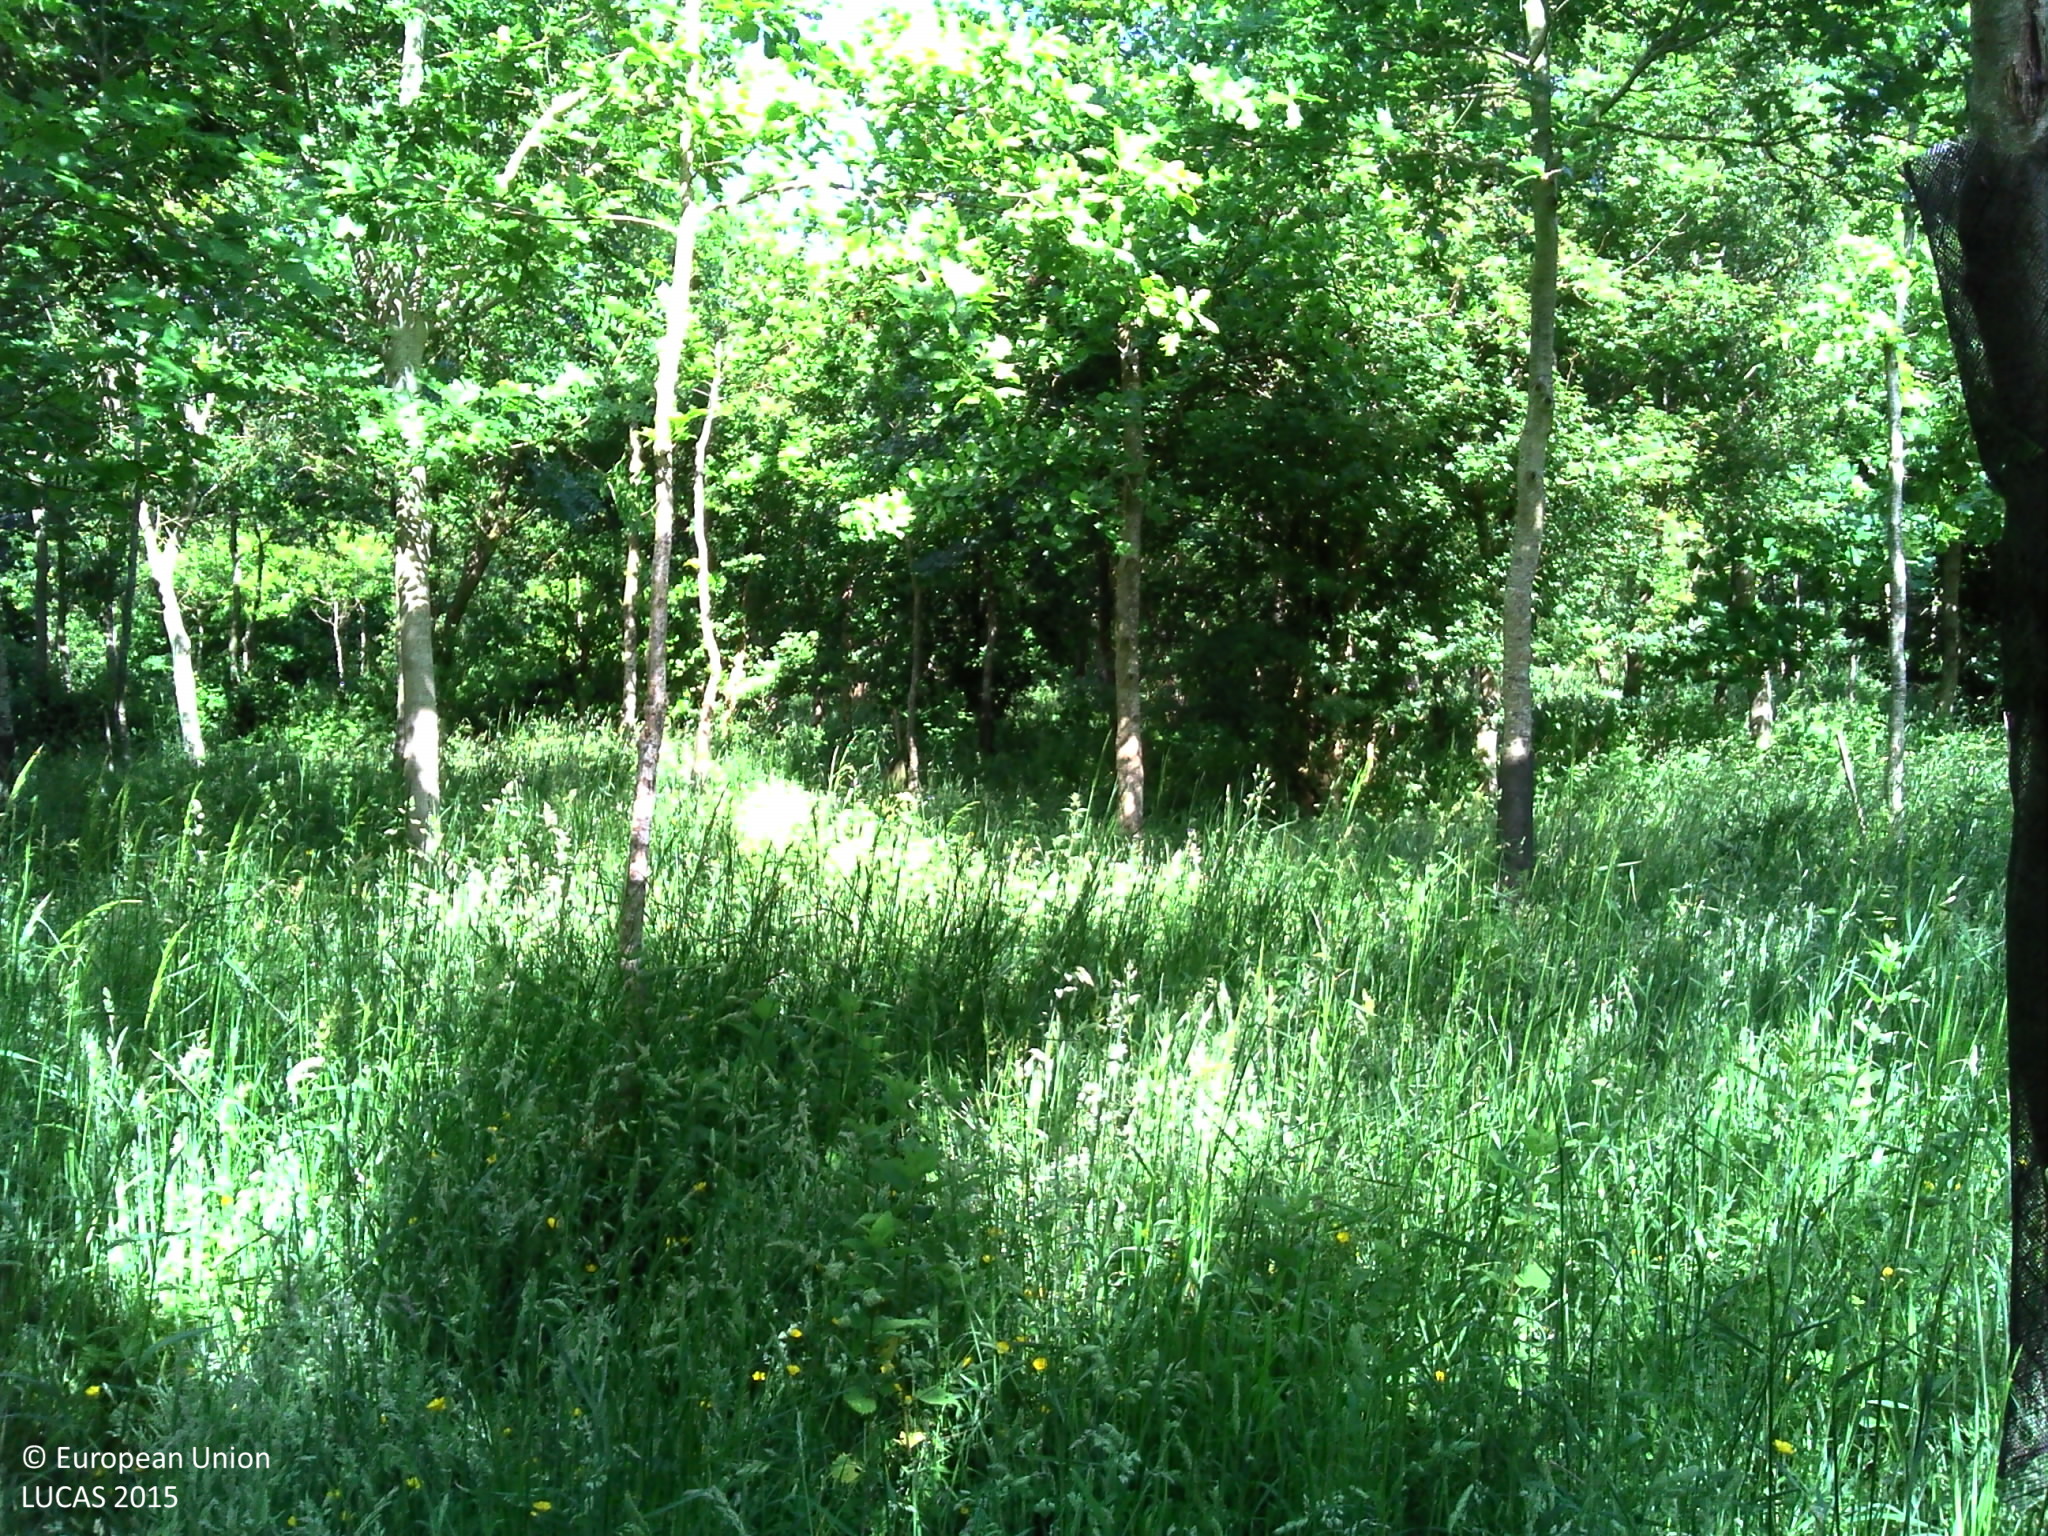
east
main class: Woodland
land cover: Broadleaved woodland
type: acidophilous oak and oak-birch forest
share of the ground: > 75 %
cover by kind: broadleaved forest trees 60 %, herbaceous plants 30 %
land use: Forestry
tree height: > 5 m
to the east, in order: Broadleaved woodland; Grassland without tree/shrub cover; Shrubland with sparse tree cover; Fences; Grassland without tree/shrub cover
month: June
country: FR
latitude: 50.7305
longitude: 1.6941
